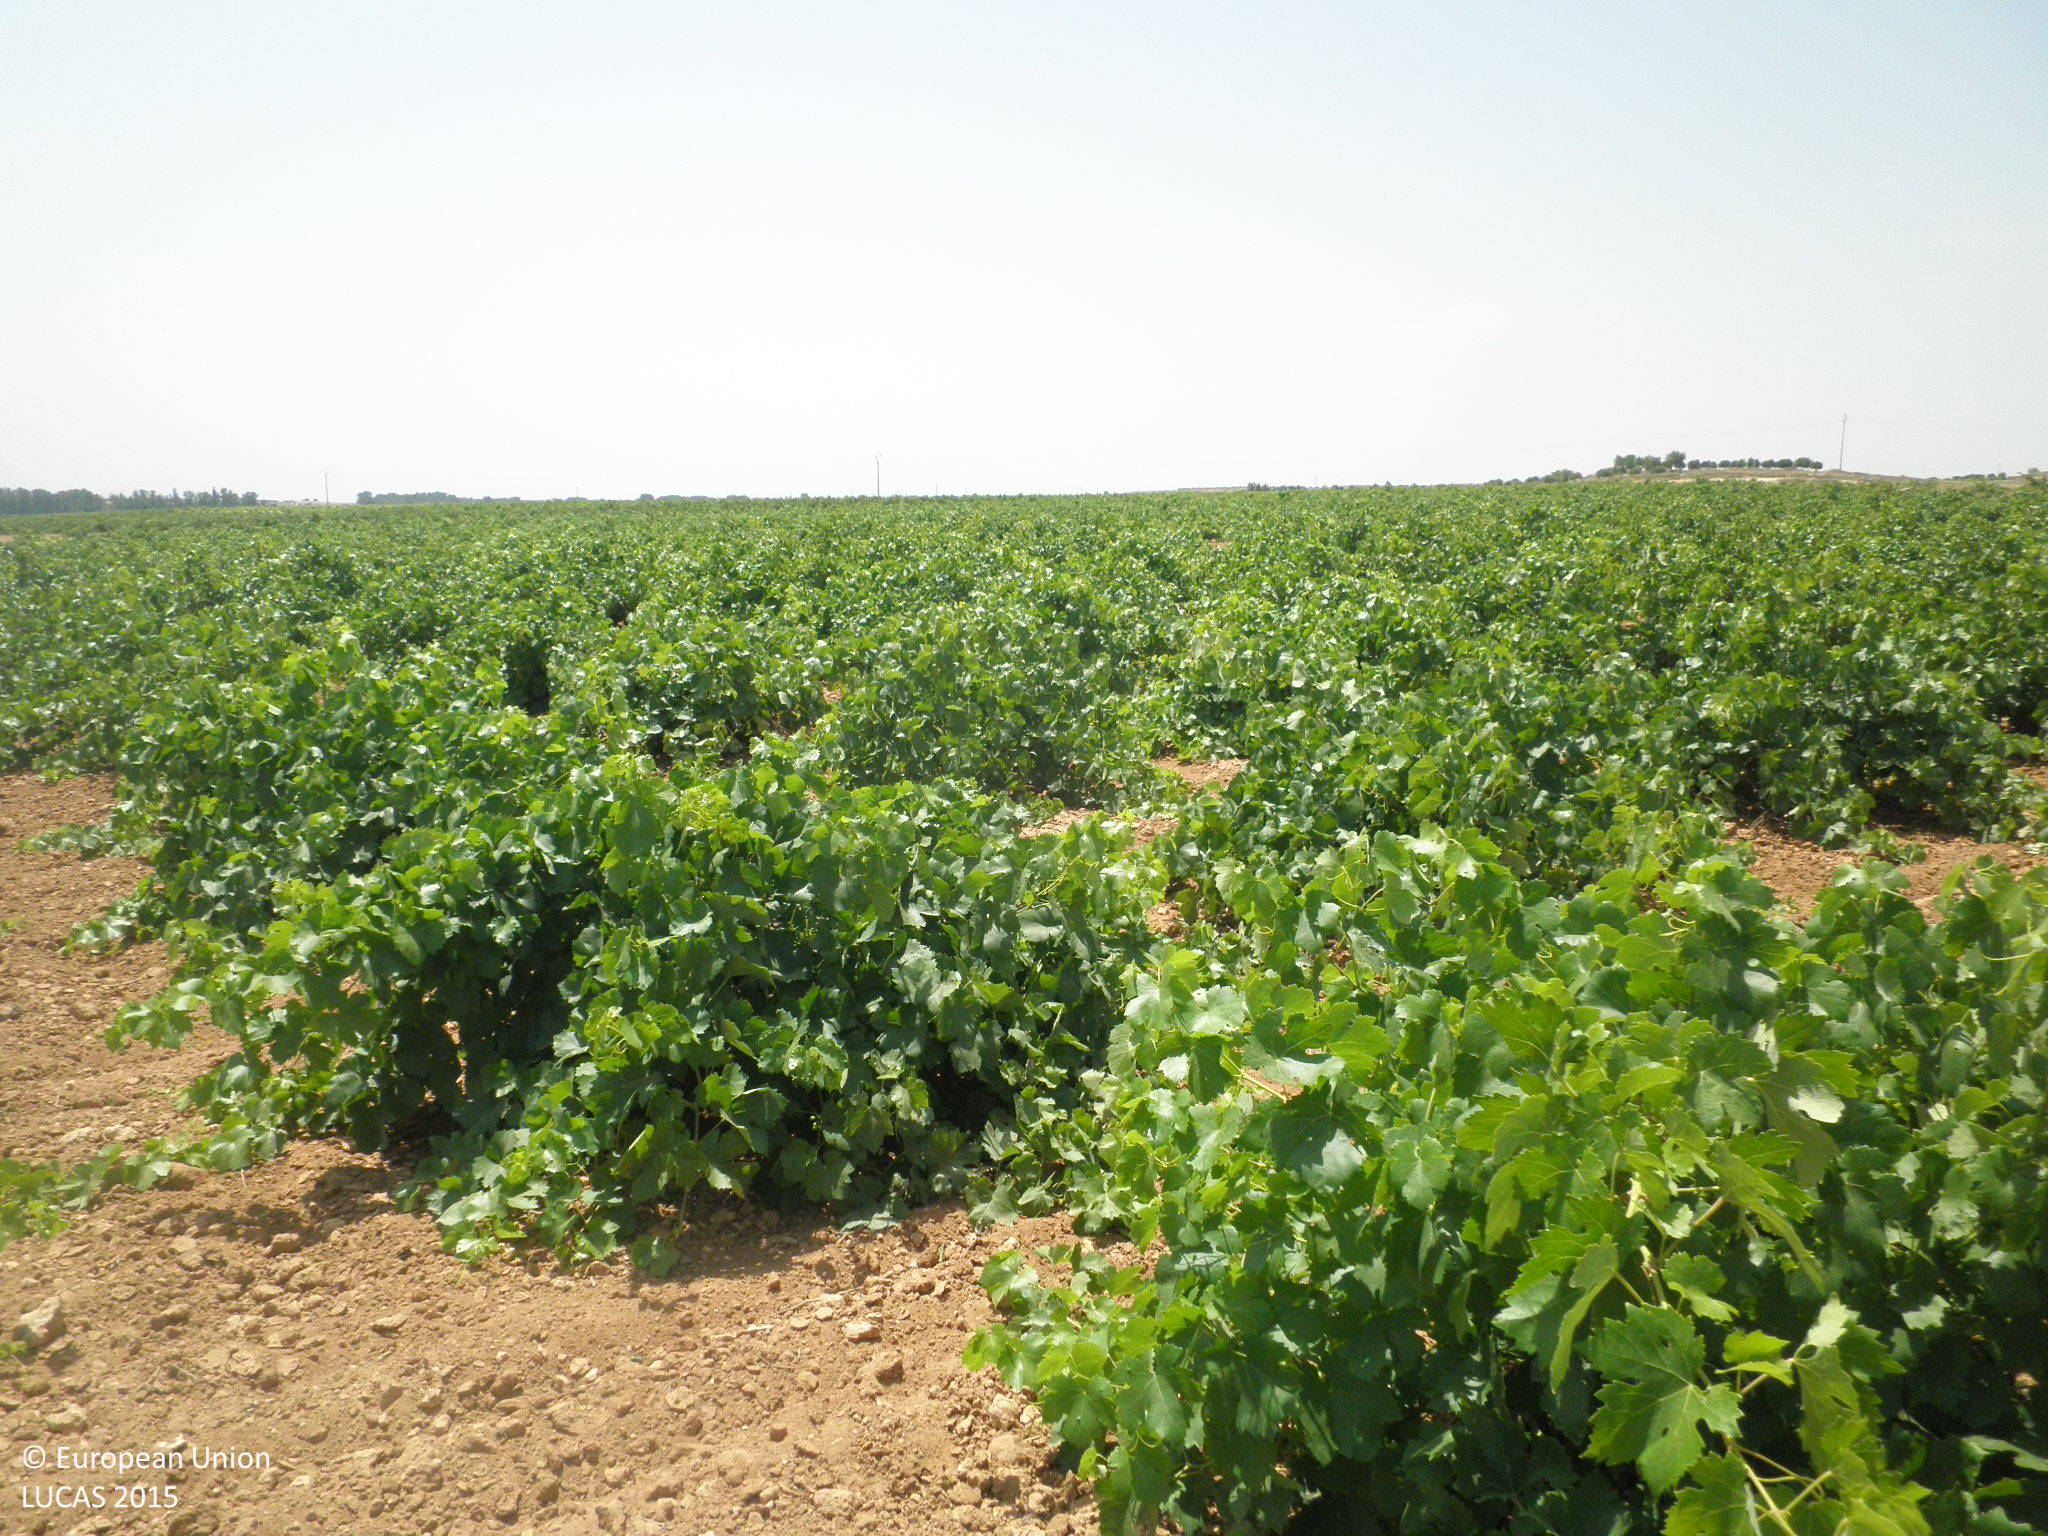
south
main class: Cropland
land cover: Vineyards
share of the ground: 25 - 50 %
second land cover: Other bare soil
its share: > 75 %
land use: Agriculture (excluding fallow land and kitchen gardens)
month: July
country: ES
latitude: 39.4990
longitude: -2.7950
